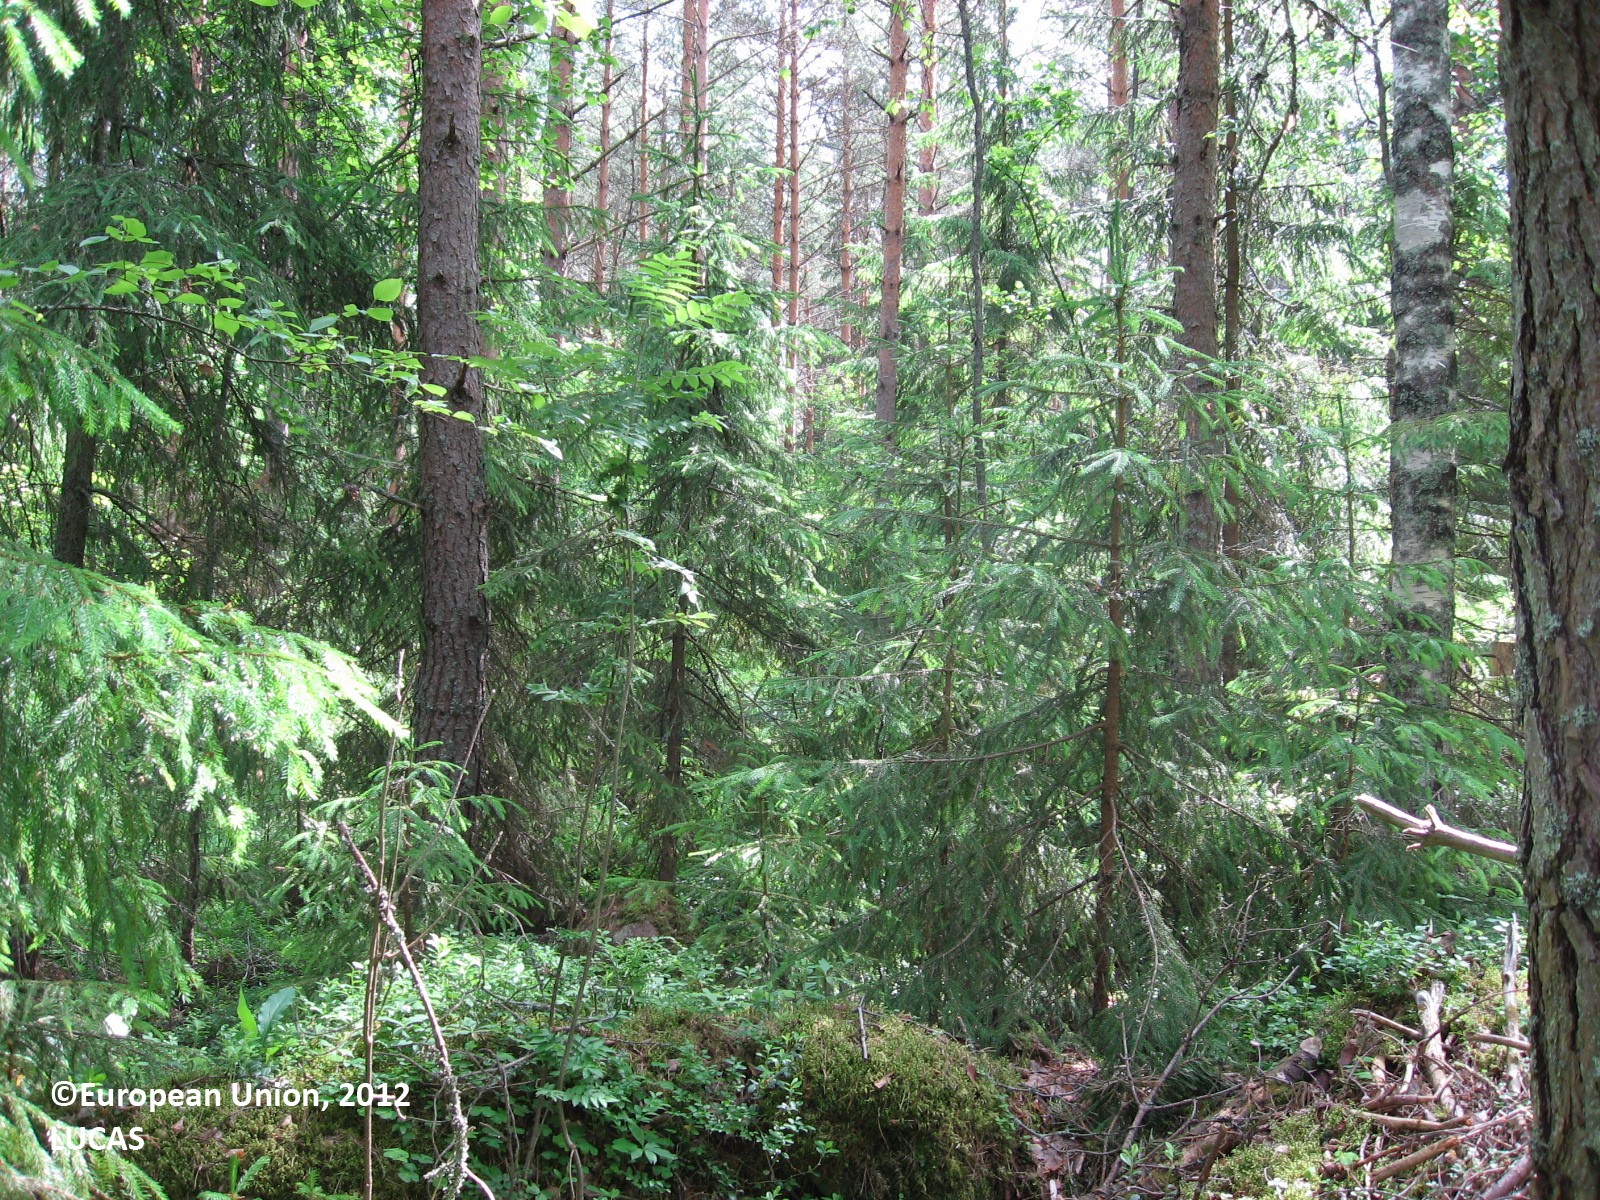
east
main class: Woodland
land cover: Other mixed woodland
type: boreal forest
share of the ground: > 75 %
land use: Forestry
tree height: > 5 m
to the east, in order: Other mixed woodland; Pine dominated mixed woodland; Spruce dominated mixed woodland; Tracks; Spruce dominated mixed woodland; Pine dominated mixed woodland; Electric lines; Grassland with sparse tree/shrub cover; Grass margins; Paved roads, cycling and walking lanes; Grassland with sparse tree/shrub cover; Electric lines
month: June
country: FI
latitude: 60.5407
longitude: 26.5443
